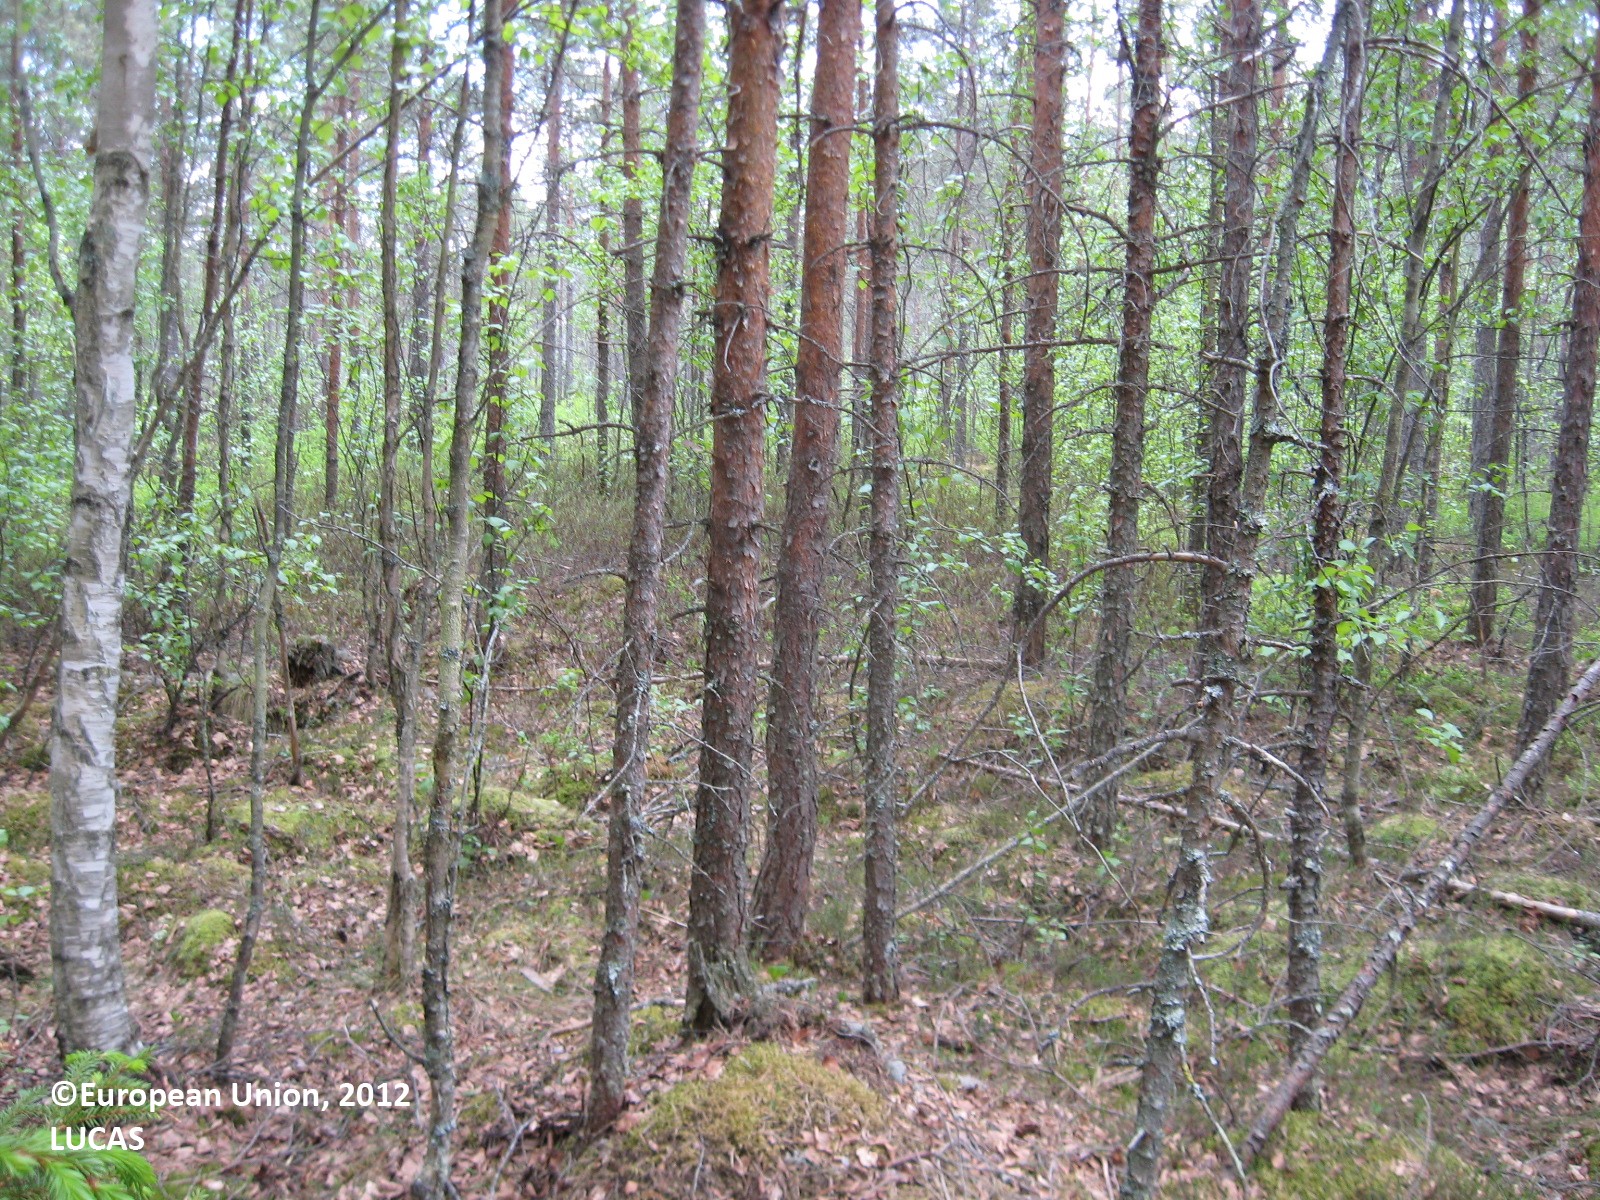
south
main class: Woodland
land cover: Pine dominated mixed woodland
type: boreal forest
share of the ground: > 75 %
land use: Forestry
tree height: > 5 m
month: June
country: FI
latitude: 63.1672
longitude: 22.7423
